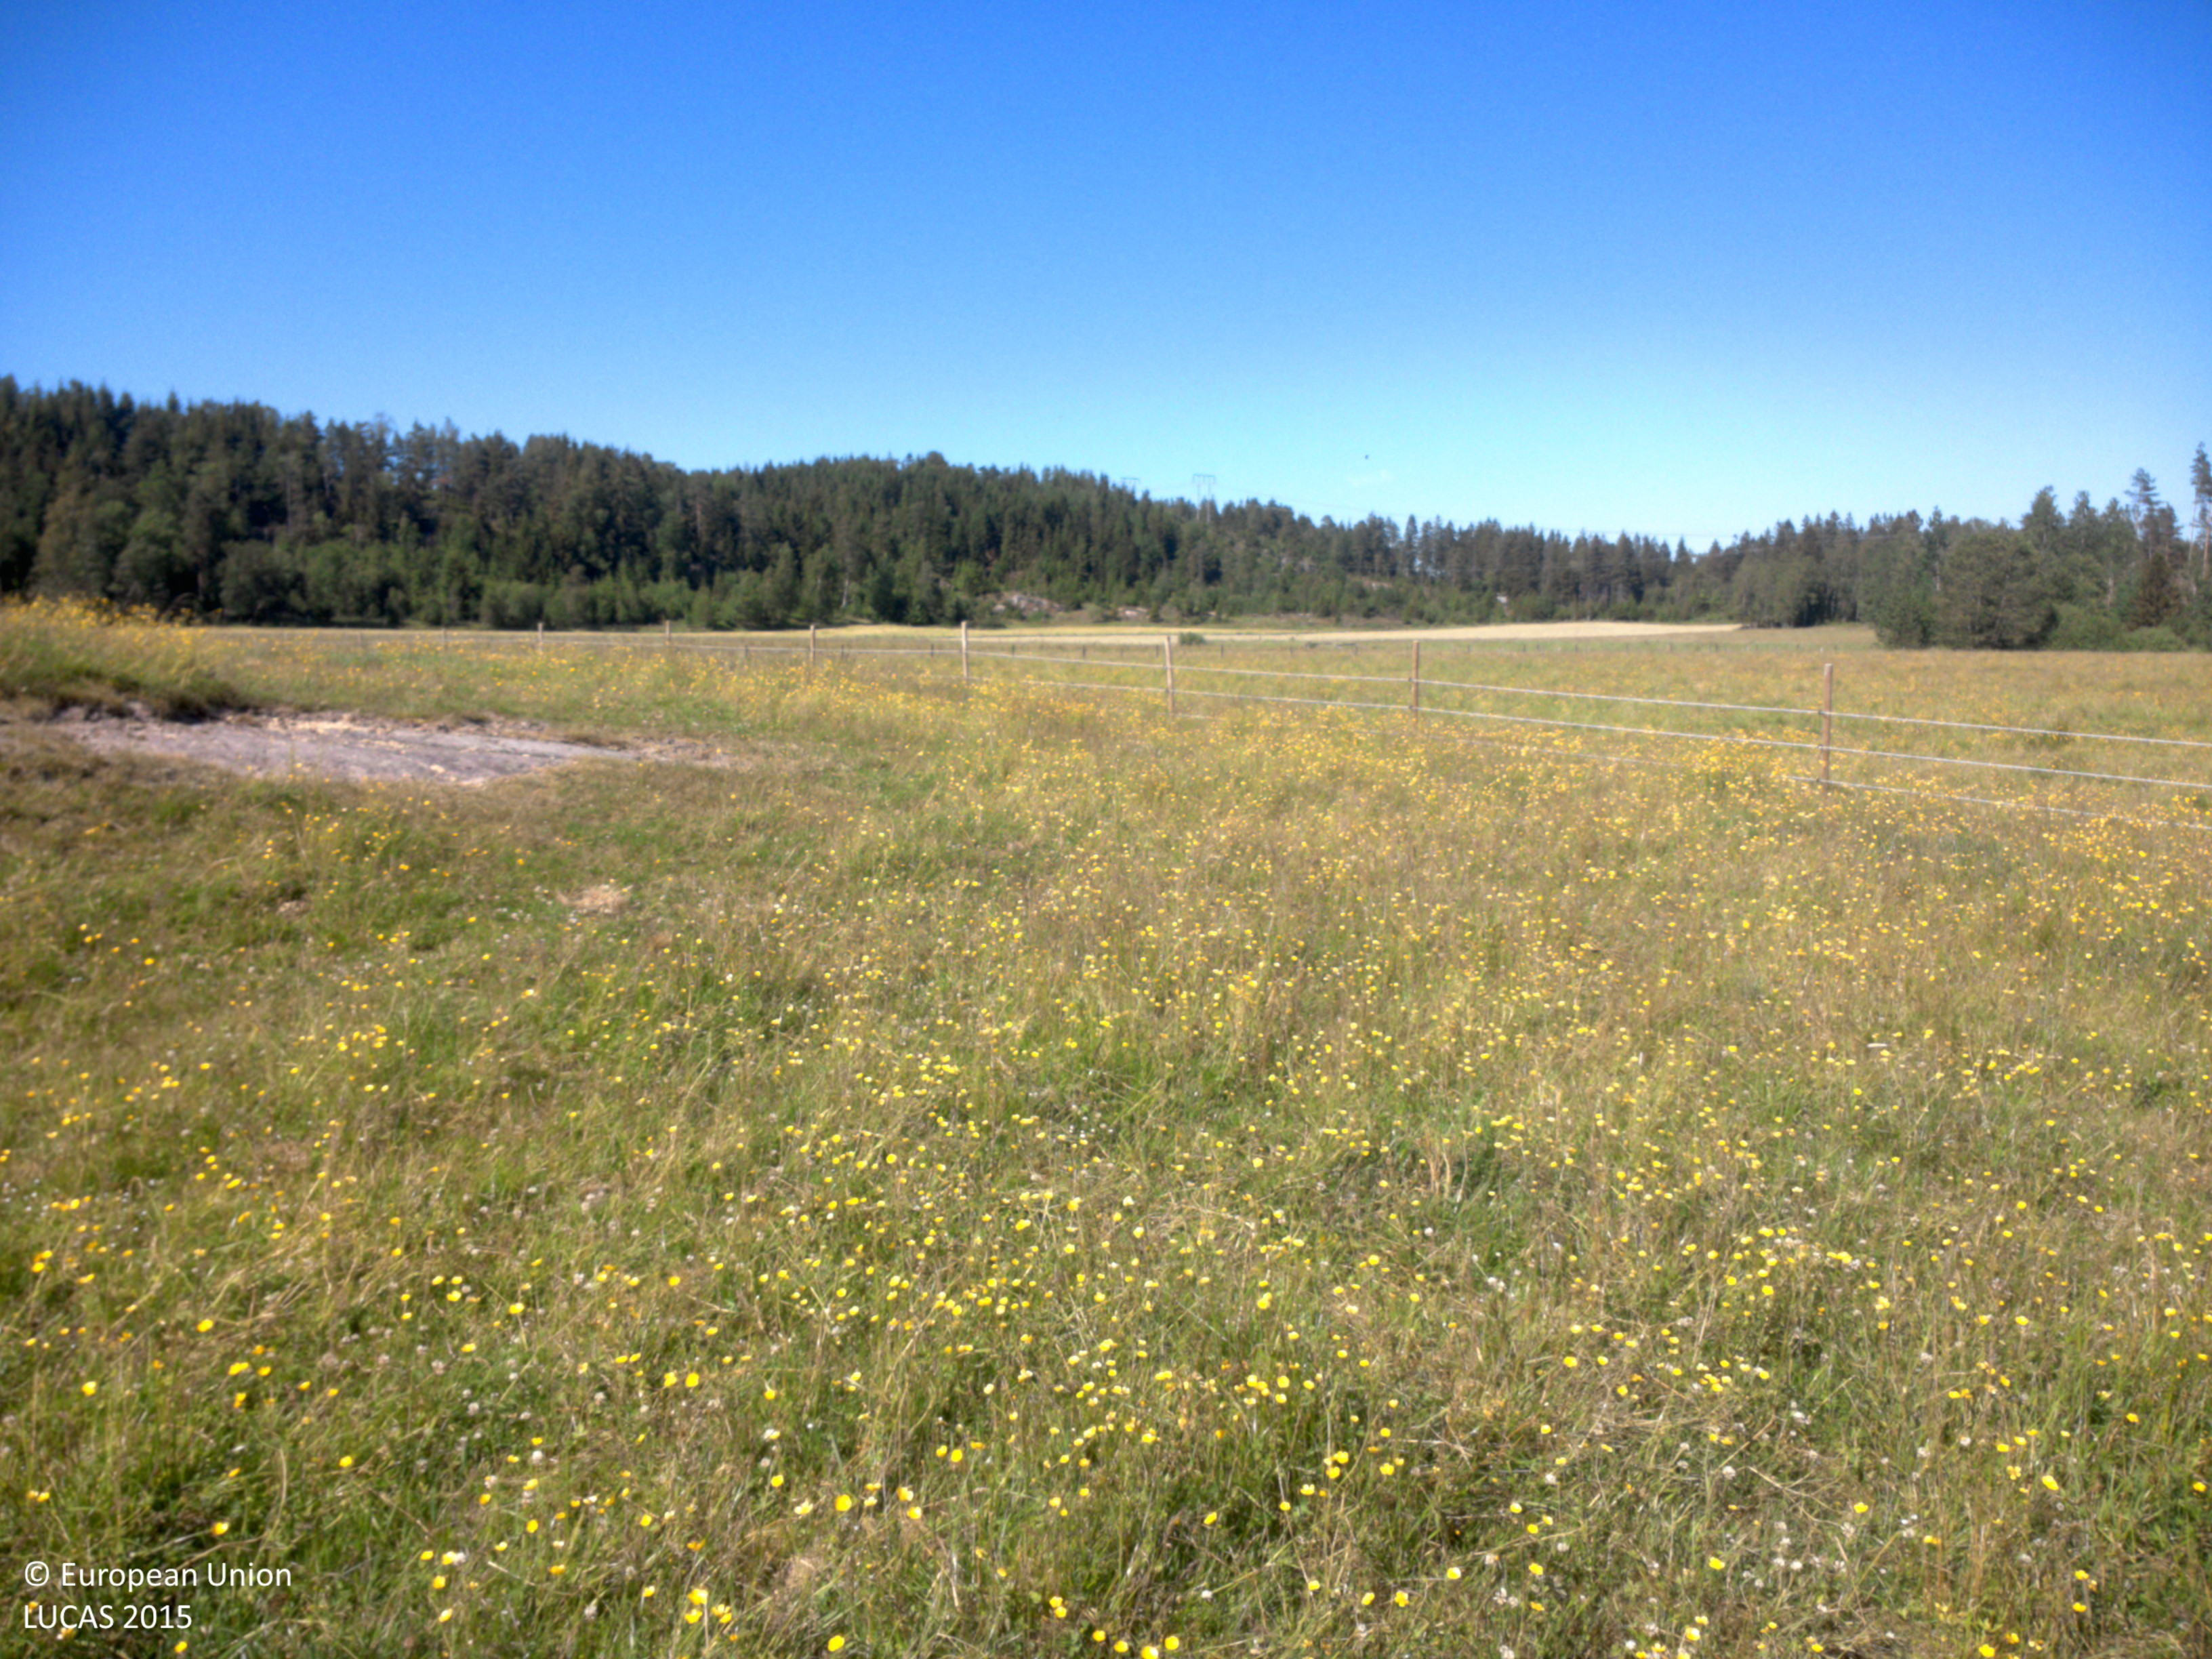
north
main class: Grassland
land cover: Grassland without tree/shrub cover
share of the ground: > 75 %
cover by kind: herbaceous plants 100 %
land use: Agriculture (excluding fallow land and kitchen gardens)
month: July
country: SE
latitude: 58.3666
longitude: 11.9961
